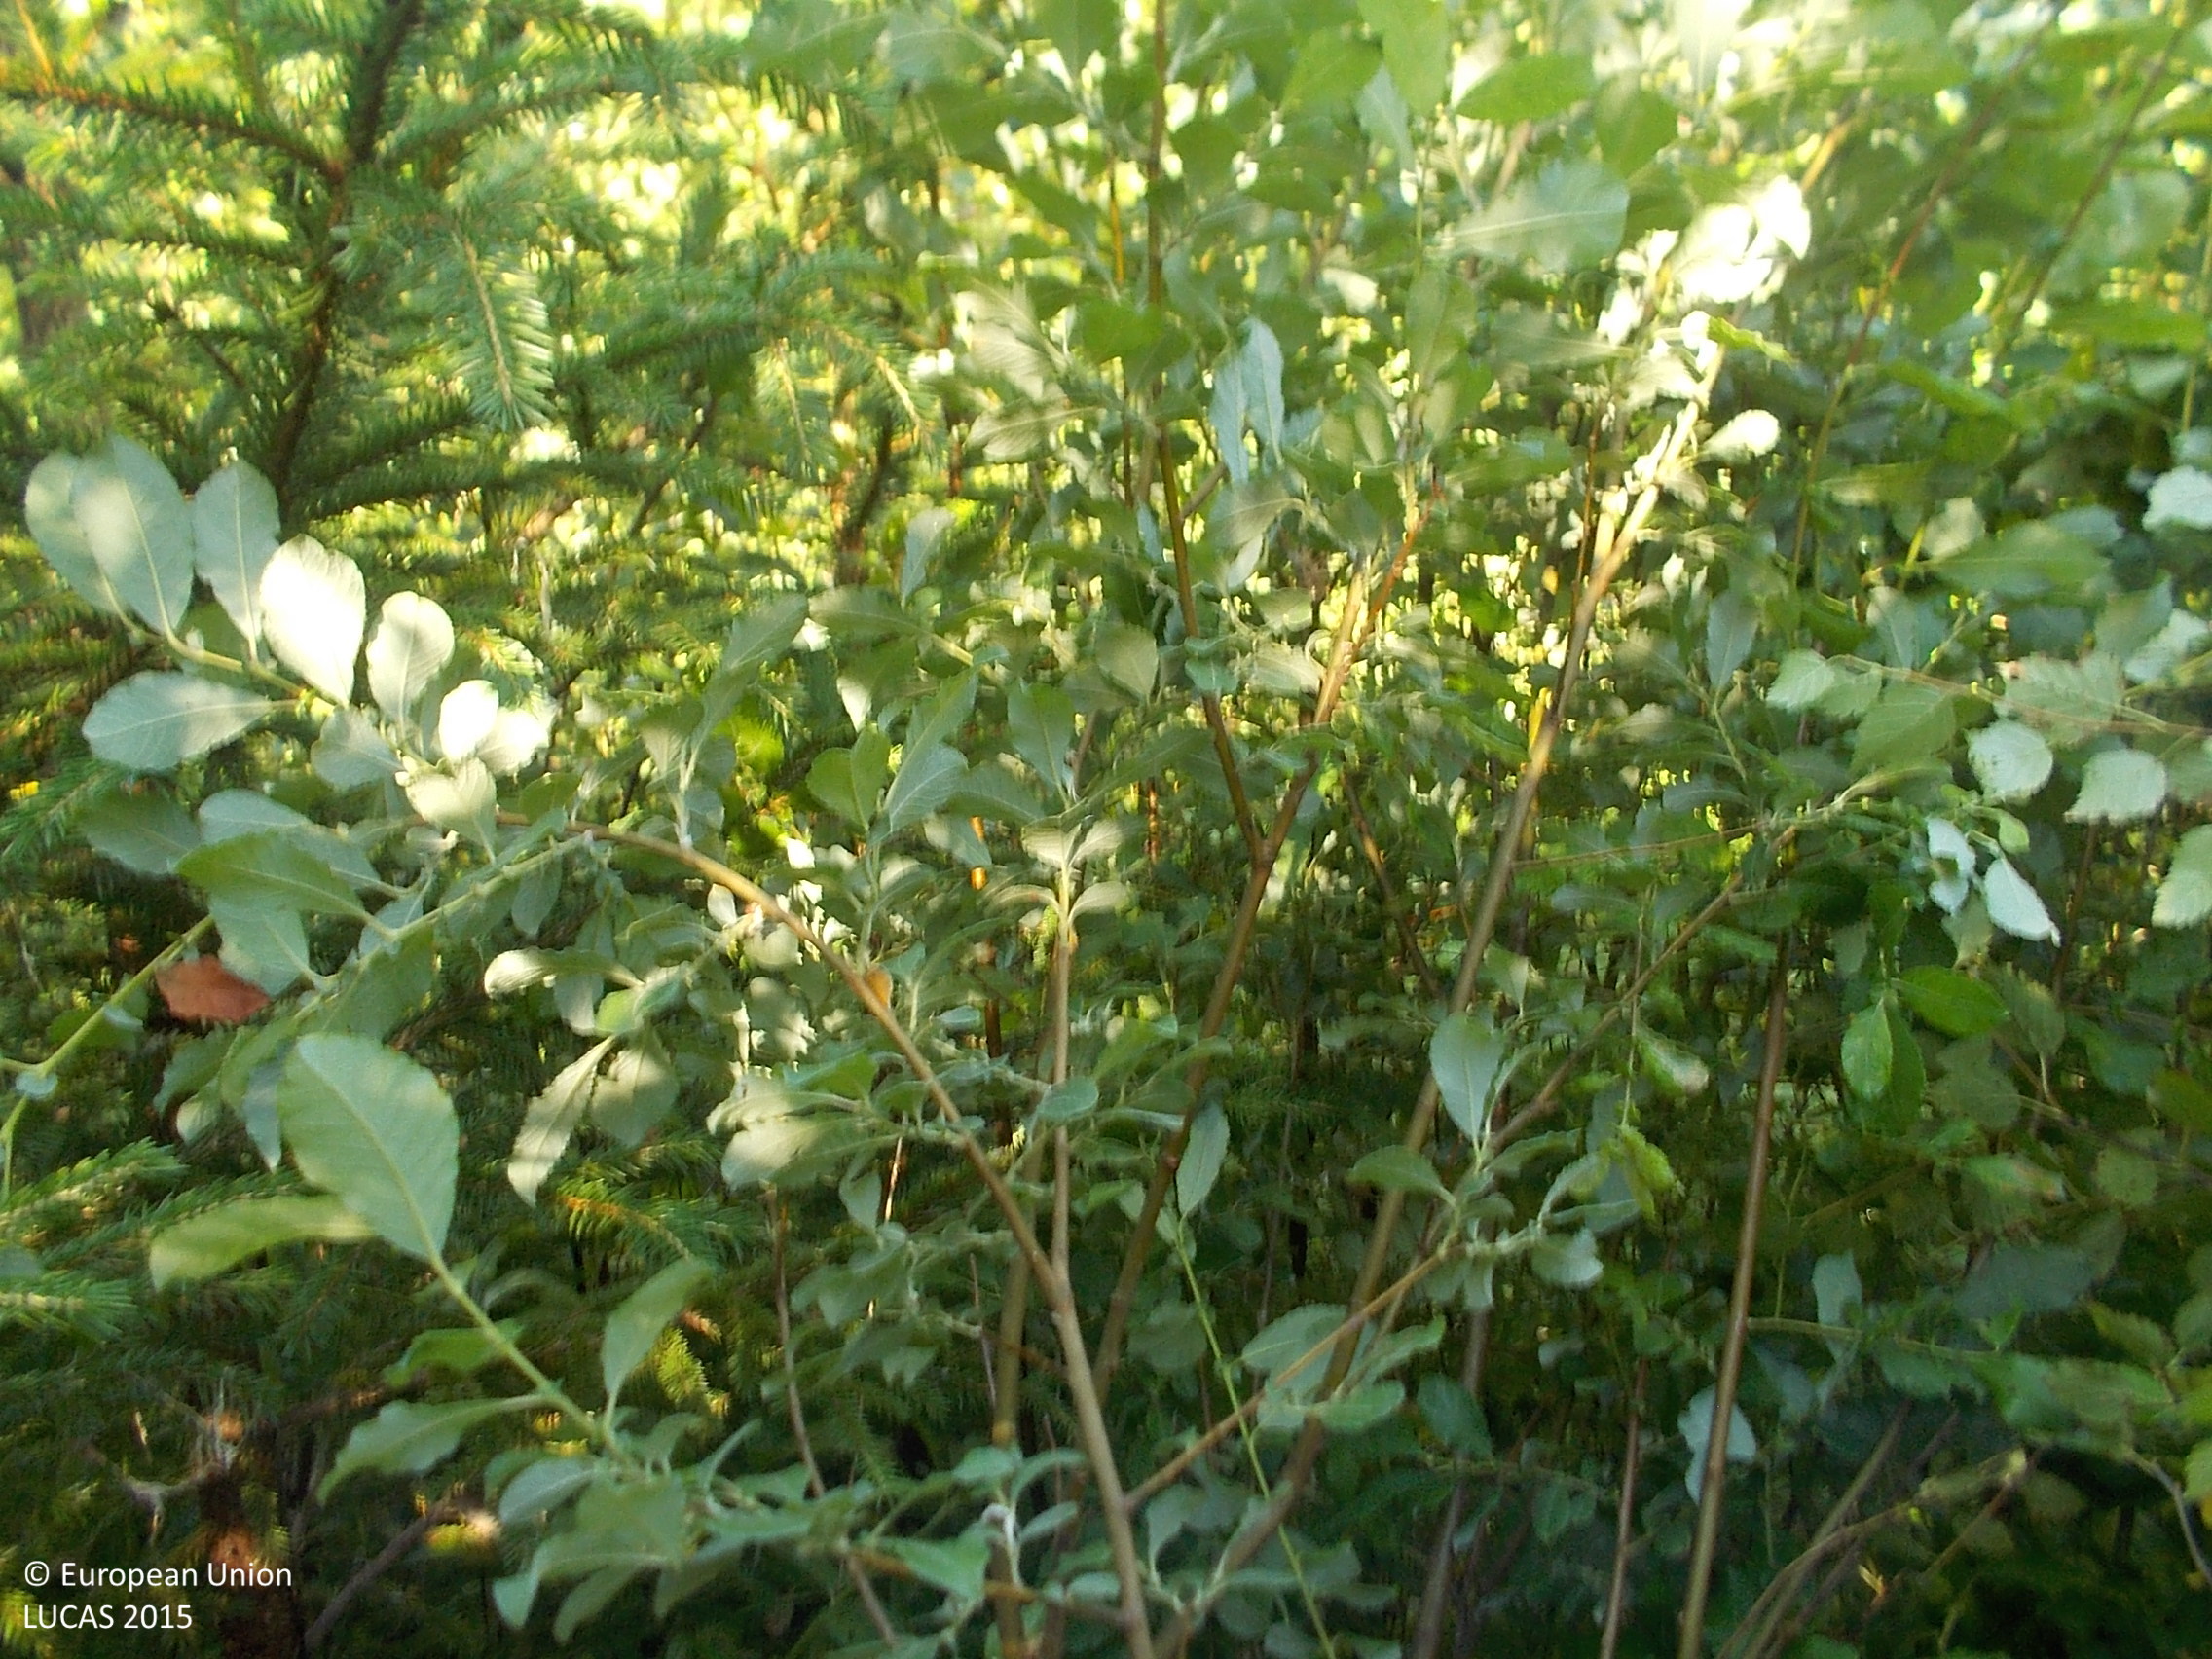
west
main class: Woodland
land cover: Spruce dominated mixed woodland
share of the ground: > 75 %
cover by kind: broadleaved forest trees 60 %, coniferous forest trees 30 %, herbaceous plants 10 %
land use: Forestry
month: August
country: SE
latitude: 57.5681
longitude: 13.2556
